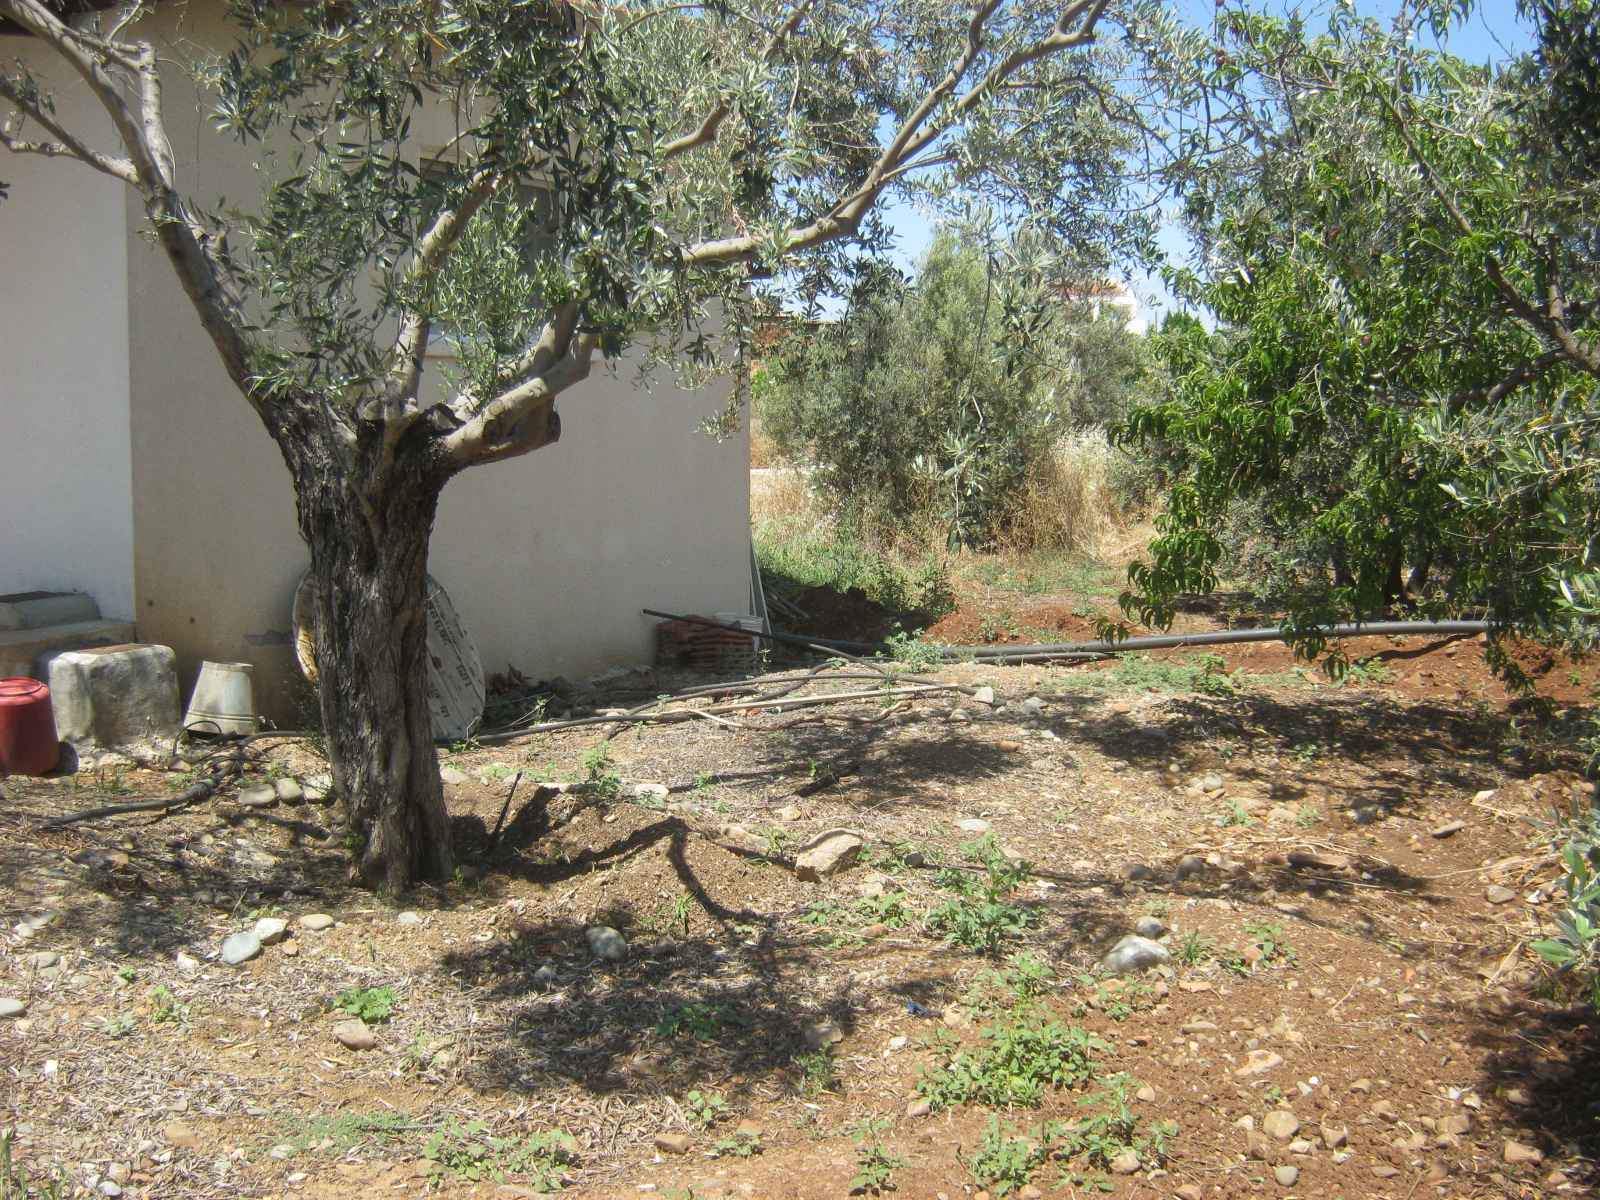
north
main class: Cropland
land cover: Olive groves
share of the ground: > 75 %
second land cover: Other bare soil
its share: > 75 %
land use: Kitchen garden
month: May
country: CY
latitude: 35.1395
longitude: 33.0420
